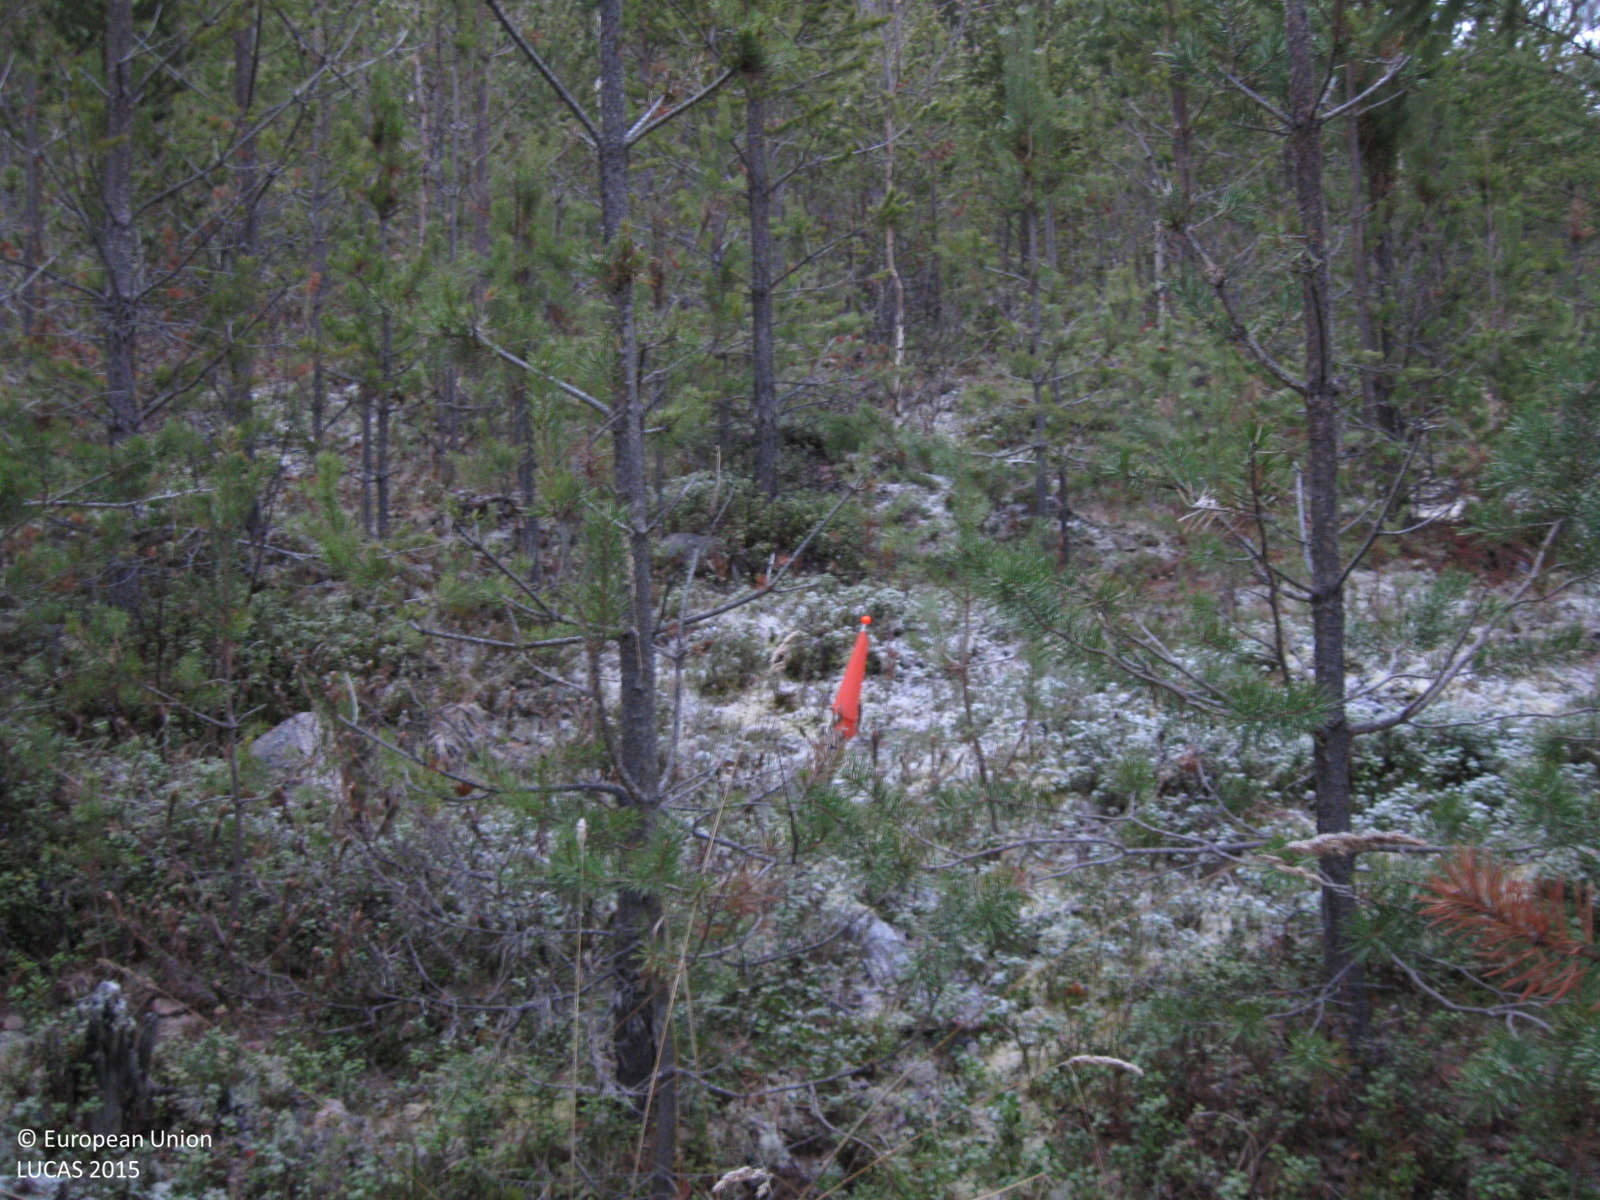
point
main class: Woodland
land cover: Pine dominated coniferous woodland
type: boreal forest
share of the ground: > 75 %
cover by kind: coniferous forest trees 80 %, broadleaved forest trees 5 %, shrubs 5 %, herbaceous plants 5 %, lichens and mosses 5 %
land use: Forestry
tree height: < 5 m
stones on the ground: 25 - 50 %
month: October
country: SE
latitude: 66.2296
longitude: 20.9674
